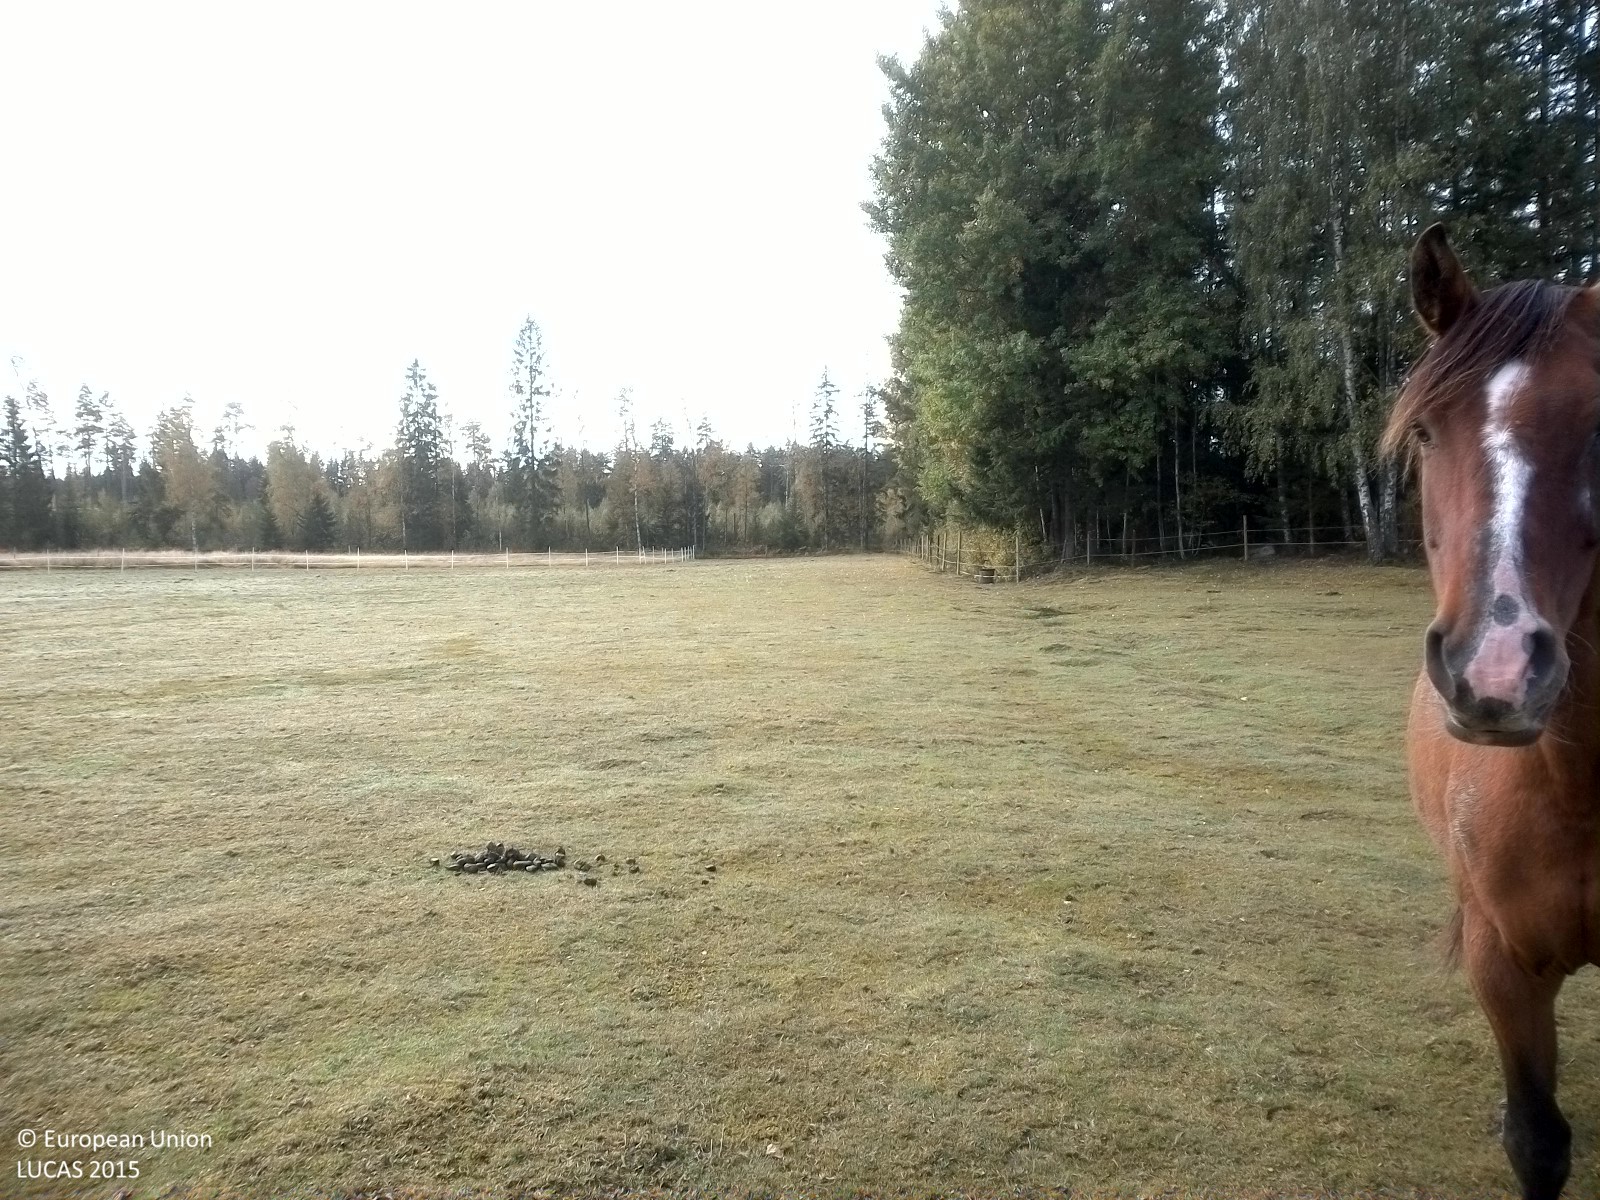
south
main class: Grassland
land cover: Grassland without tree/shrub cover
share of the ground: > 75 %
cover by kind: herbaceous plants 90 %, consolidated bare surface 10 %
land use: Agriculture (excluding fallow land and kitchen gardens)
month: September
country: SE
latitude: 58.6612
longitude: 16.8055
